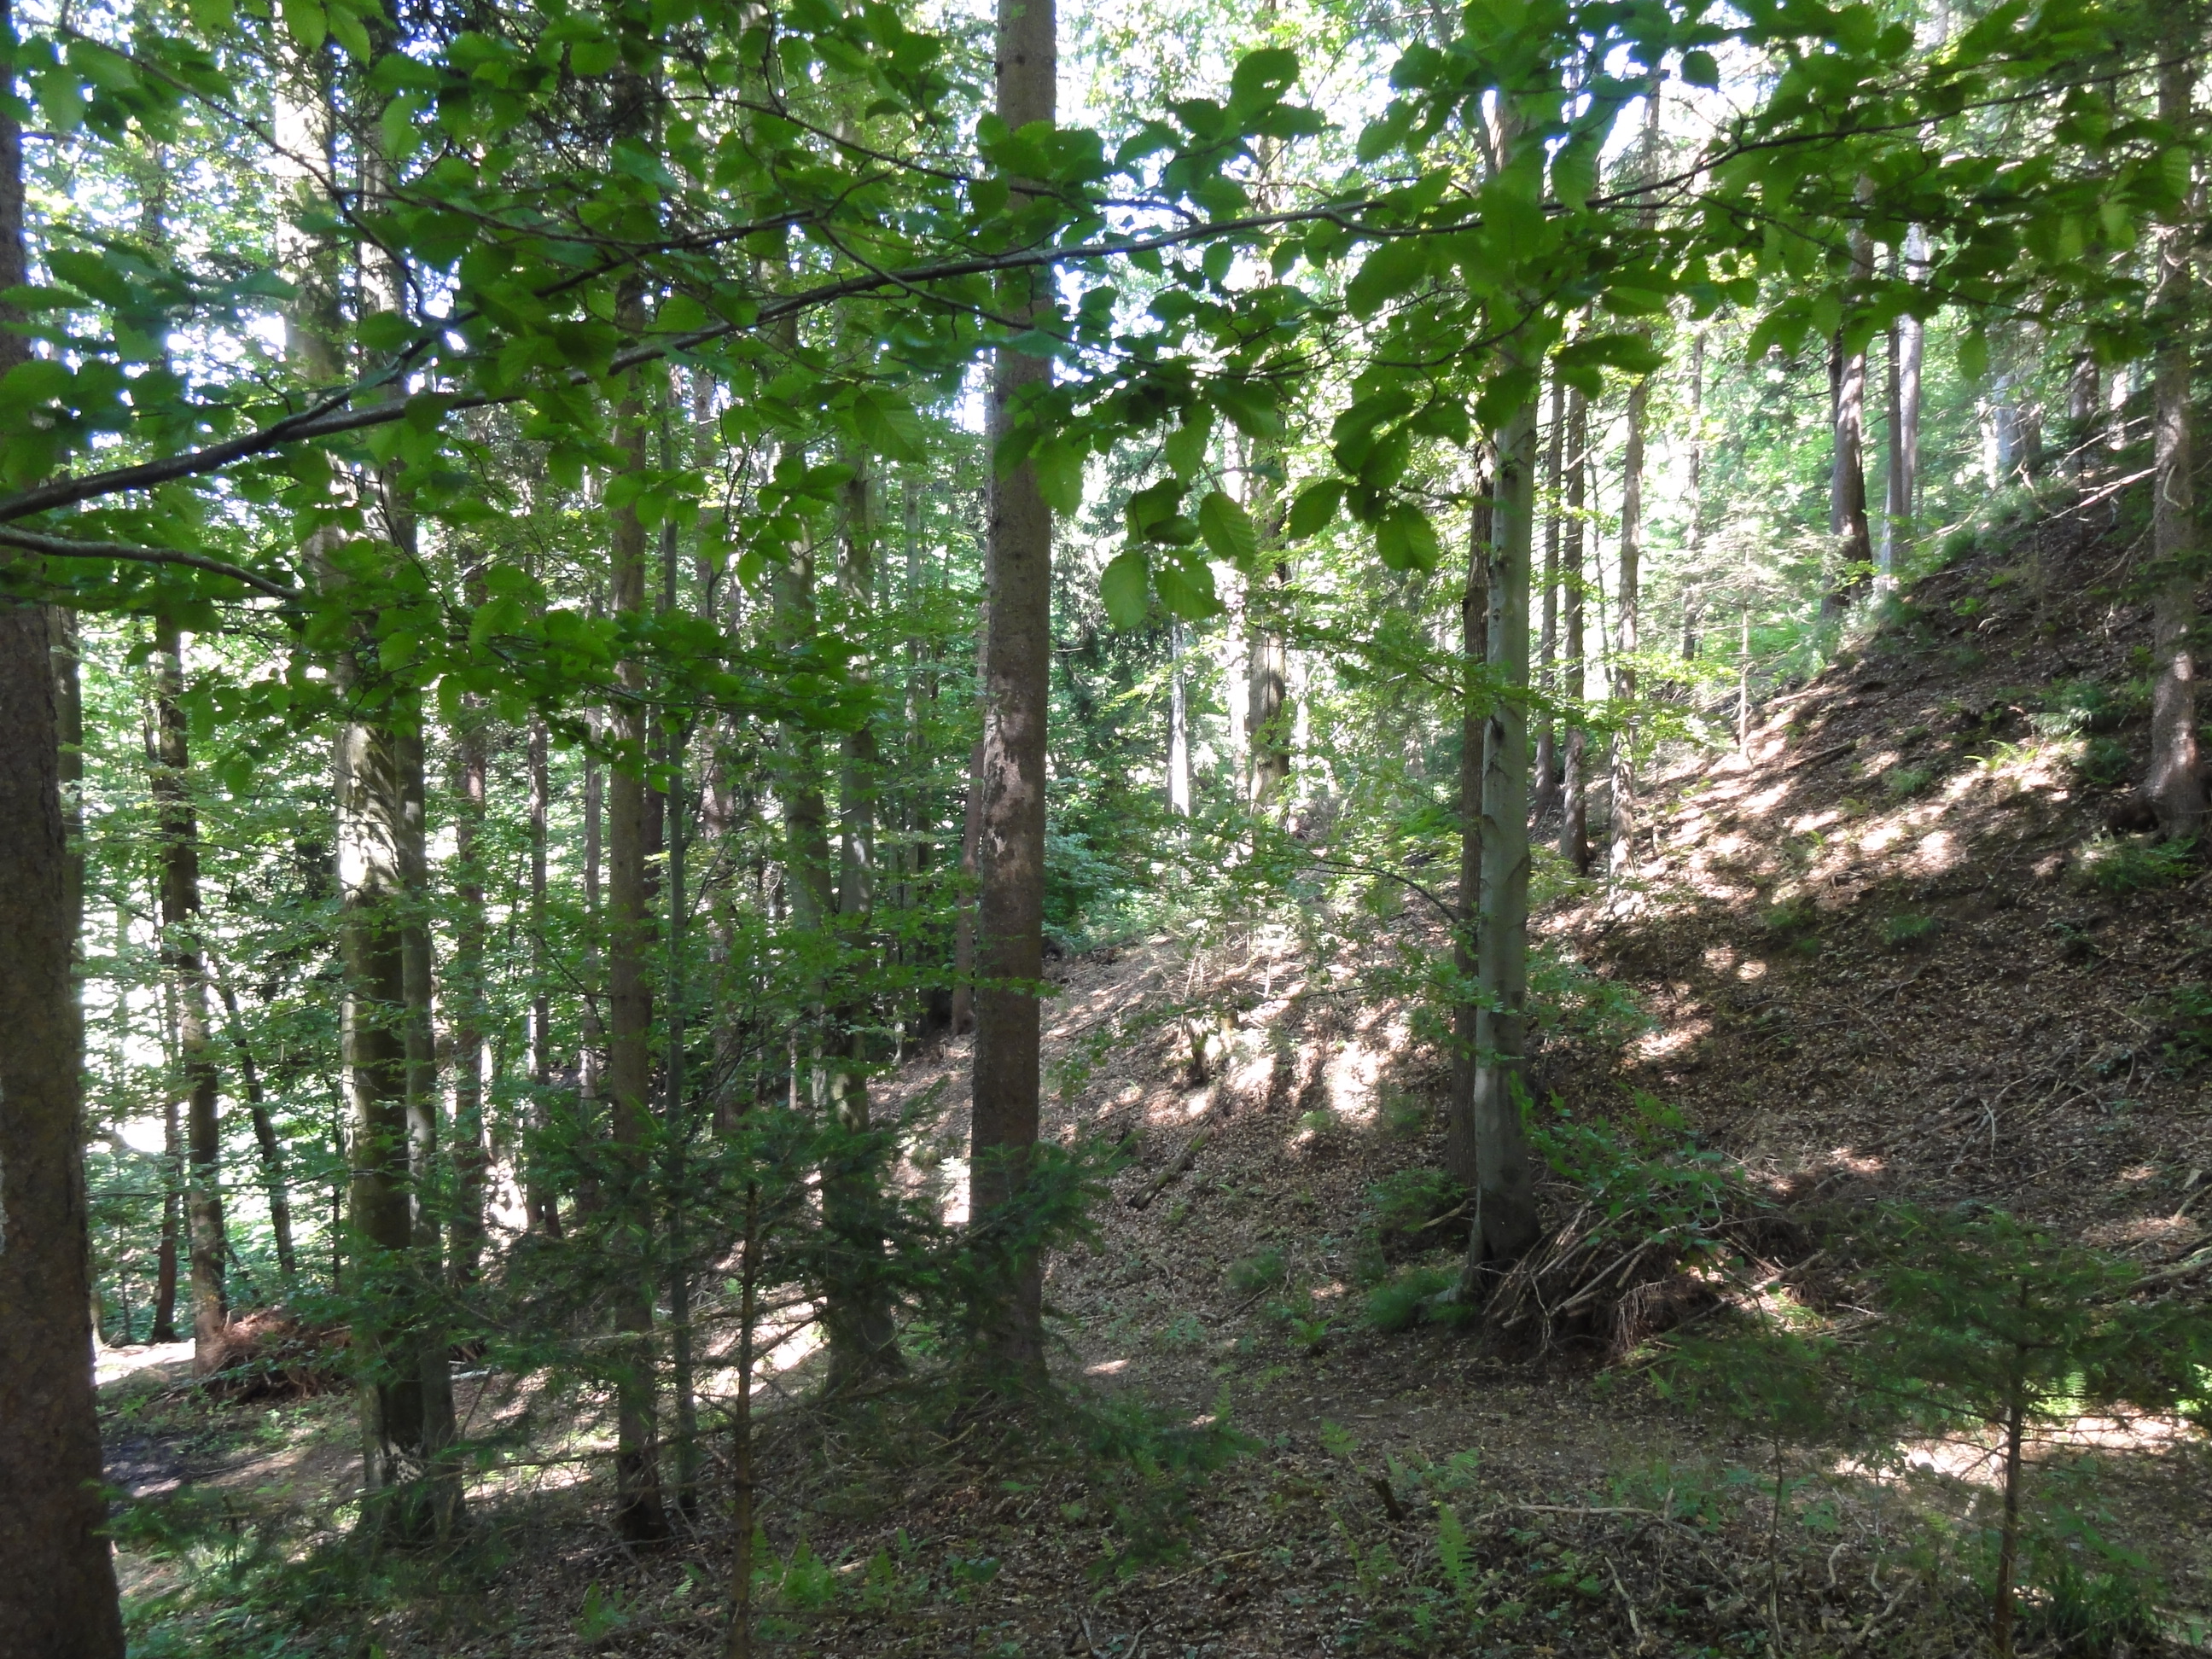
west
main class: Woodland
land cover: Spruce dominated mixed woodland
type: mountainous beech forest
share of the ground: > 75 %
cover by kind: broadleaved forest trees 65 %, coniferous forest trees 35 %
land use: Forestry
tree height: > 5 m
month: June
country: SI
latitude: 46.1772
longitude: 15.0622
